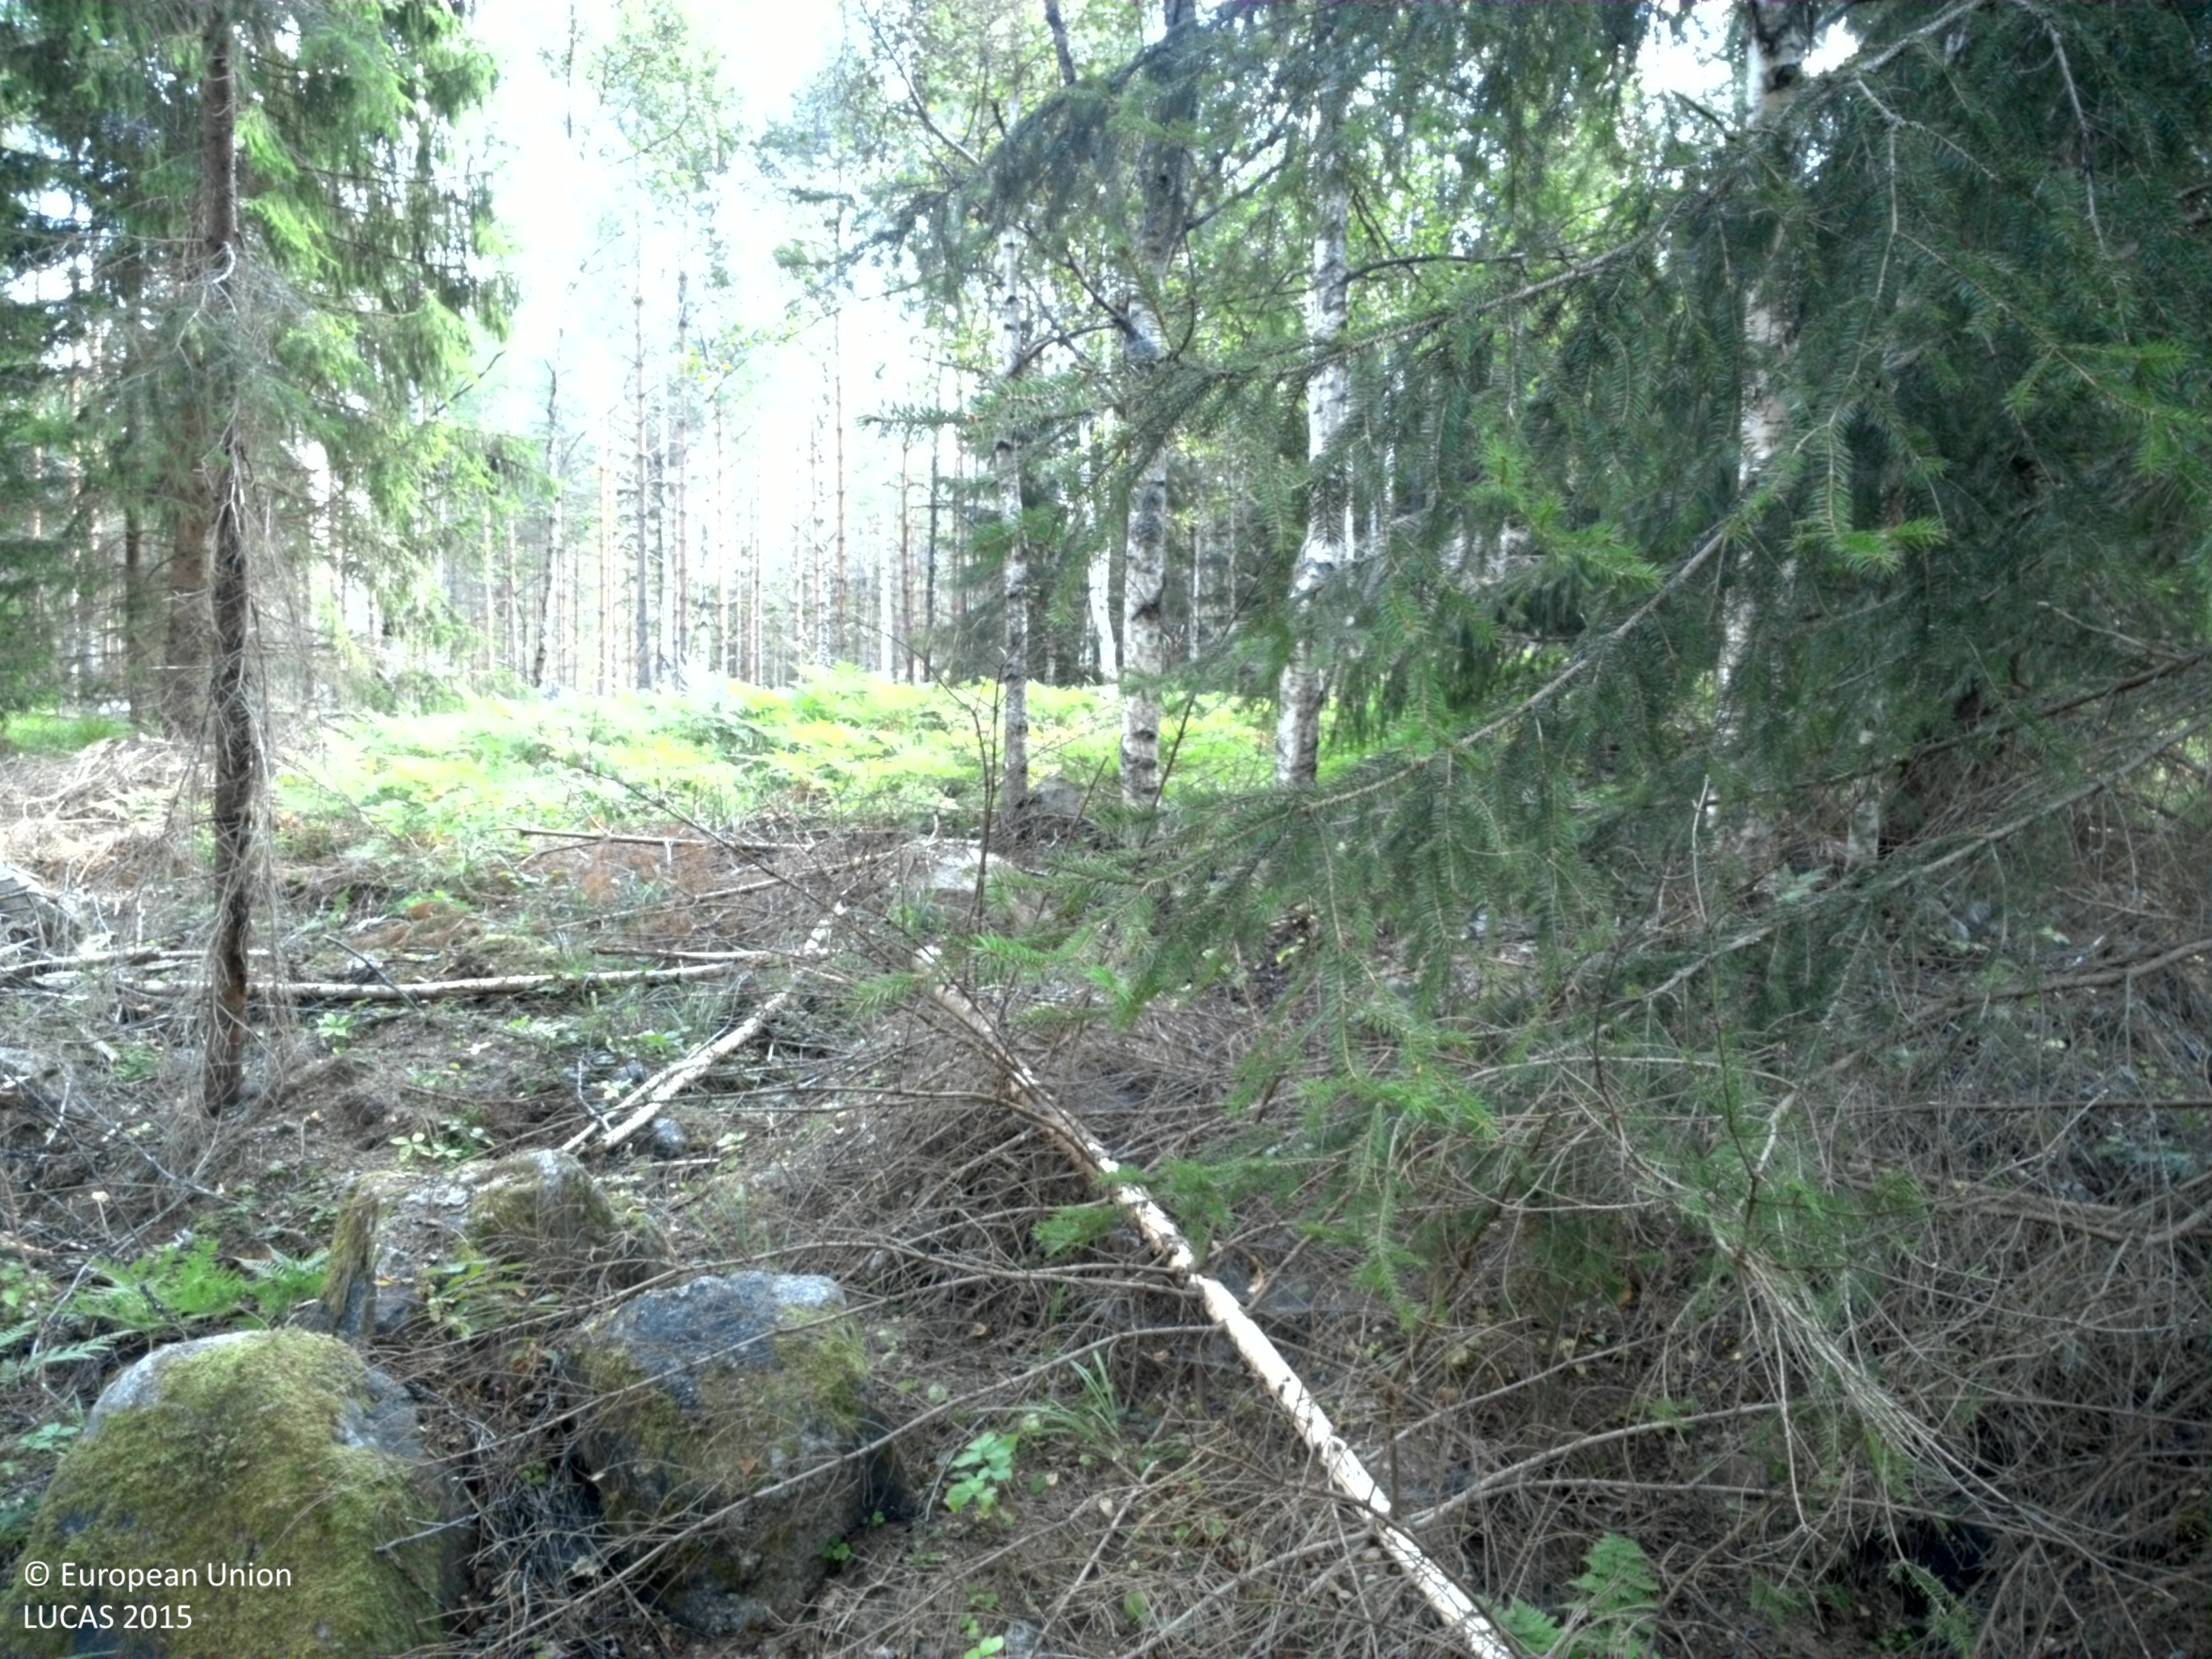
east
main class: Woodland
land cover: Spruce dominated mixed woodland
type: boreal forest
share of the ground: > 75 %
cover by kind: coniferous forest trees 60 %, broadleaved forest trees 20 %, lichens and mosses 20 %
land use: Forestry
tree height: > 5 m
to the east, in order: Spruce dominated mixed woodland; Tracks; Pine dominated coniferous woodland; Spruce dominated coniferous woodland
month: August
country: SE
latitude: 60.1084
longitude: 17.8191
